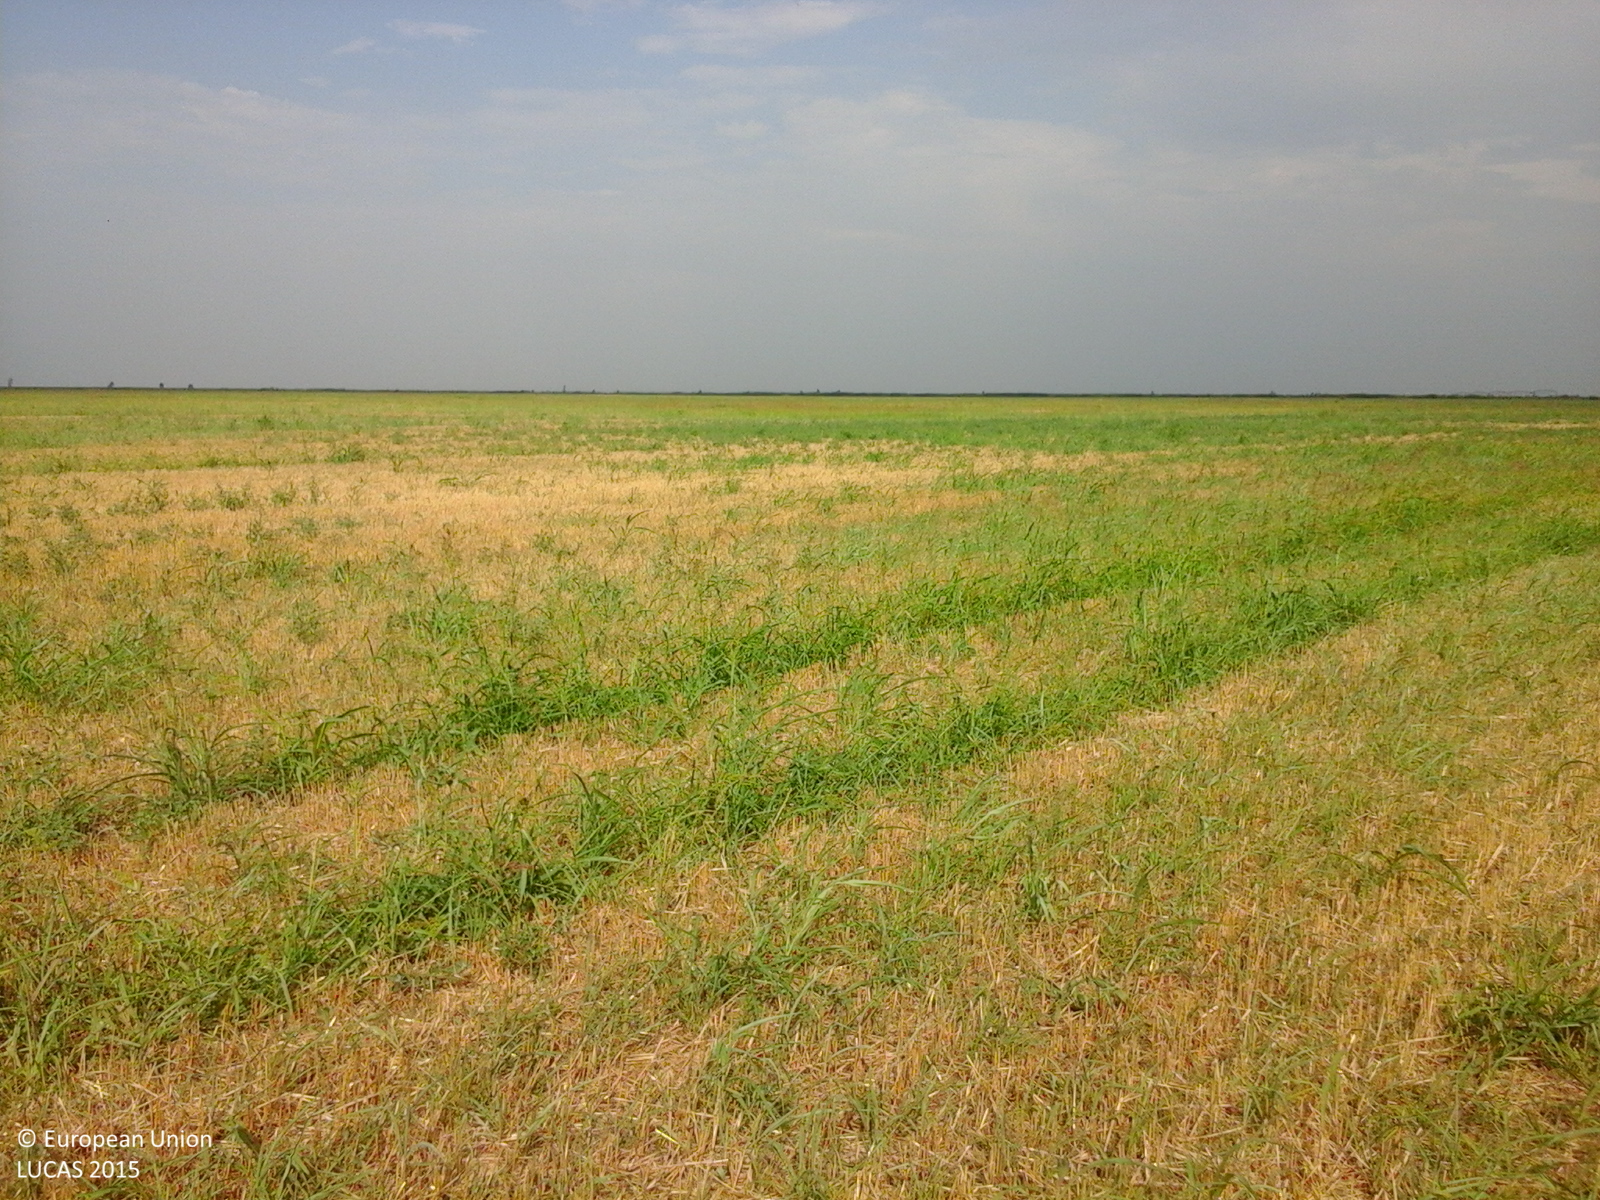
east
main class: Cropland
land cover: Common wheat
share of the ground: > 75 %
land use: Agriculture (excluding fallow land and kitchen gardens)
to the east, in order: Common wheat
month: August
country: RO
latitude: 45.0197
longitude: 27.6268
